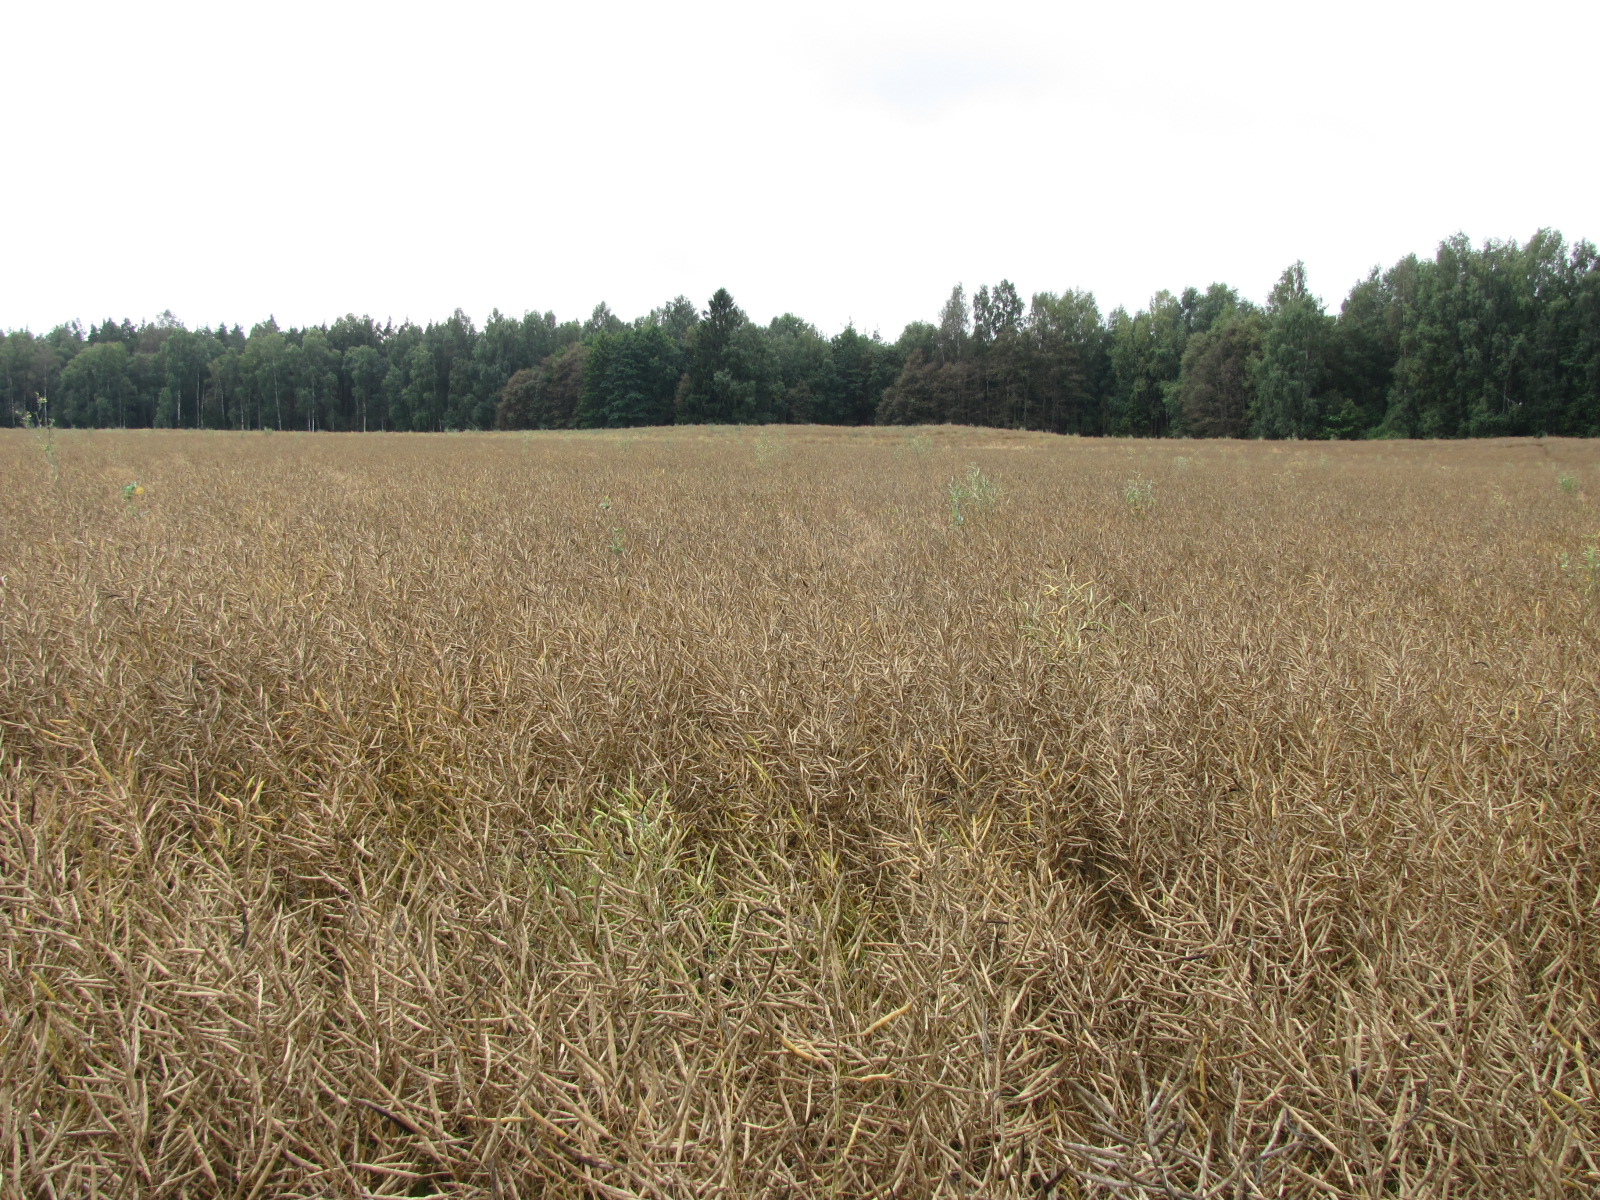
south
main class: Cropland
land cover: Rape and turnip rape
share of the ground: > 75 %
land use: Agriculture (excluding fallow land and kitchen gardens)
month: September
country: LV
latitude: 56.6388
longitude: 25.2942
